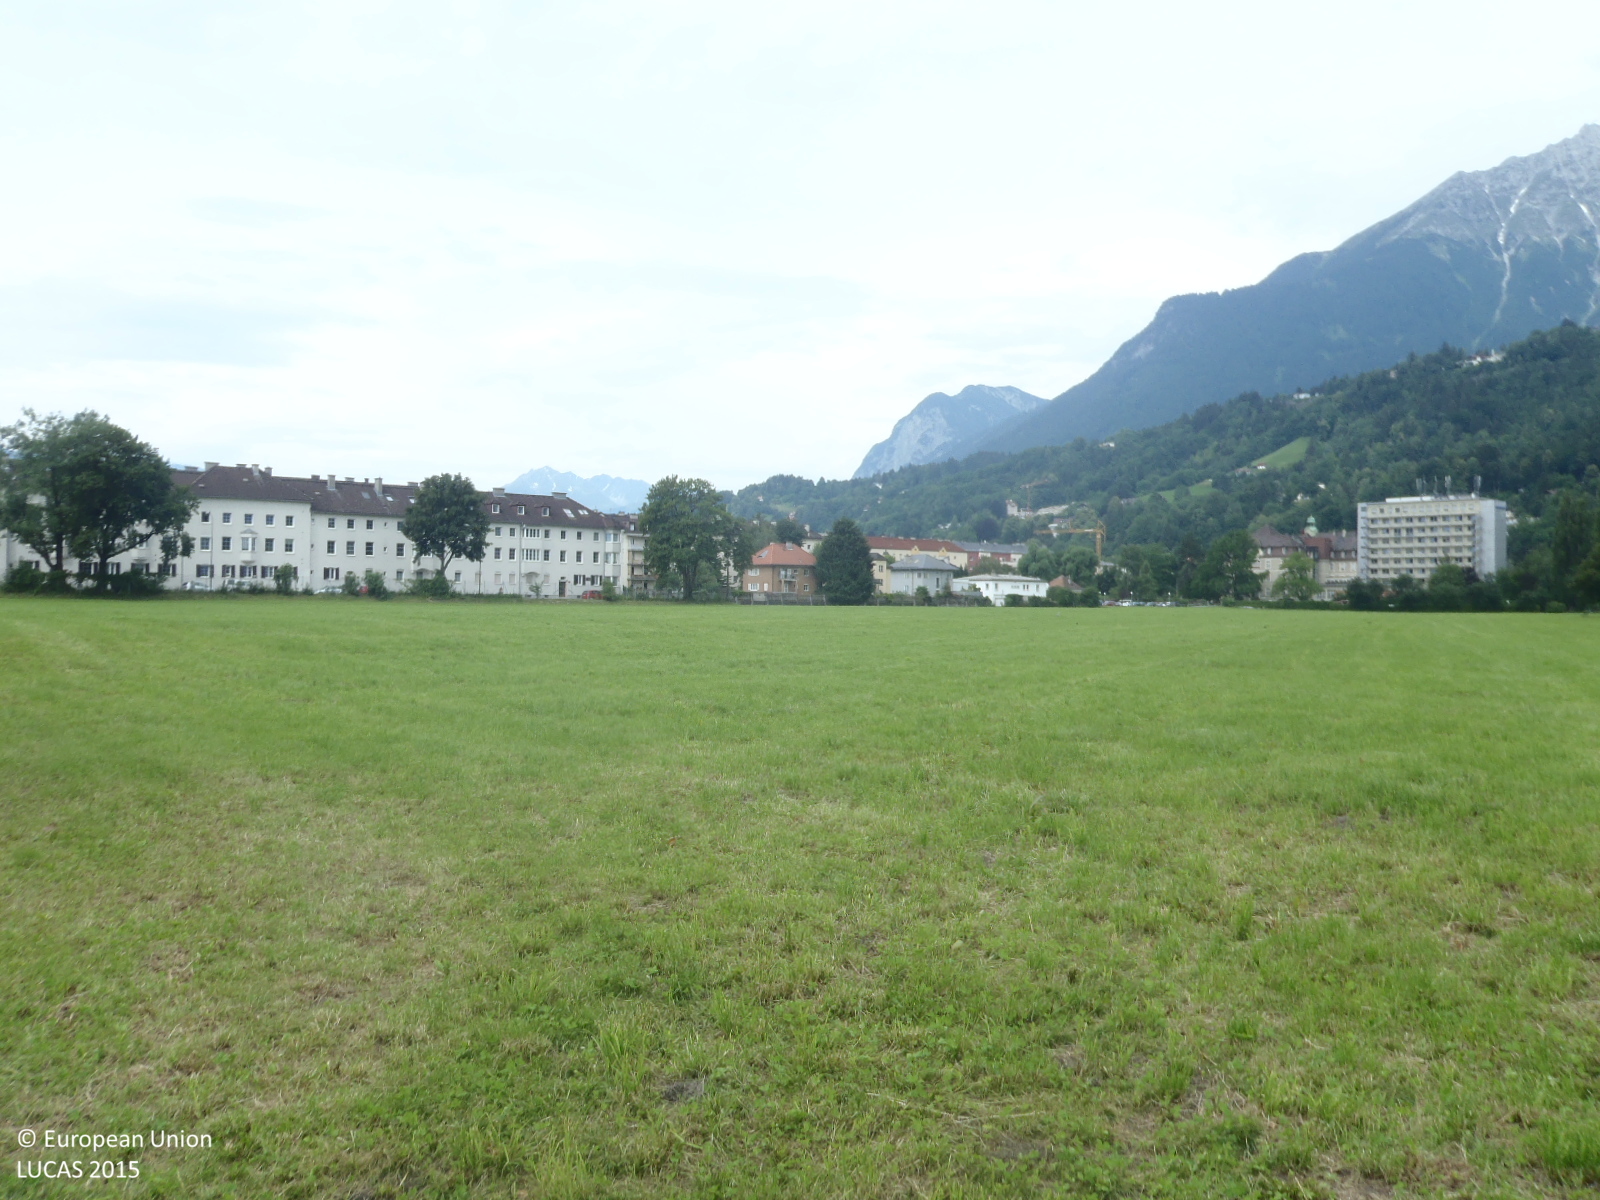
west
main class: Grassland
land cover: Grassland without tree/shrub cover
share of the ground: > 75 %
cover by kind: herbaceous plants 100 %
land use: Agriculture (excluding fallow land and kitchen gardens)
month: June
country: AT
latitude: 47.2784
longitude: 11.4132
